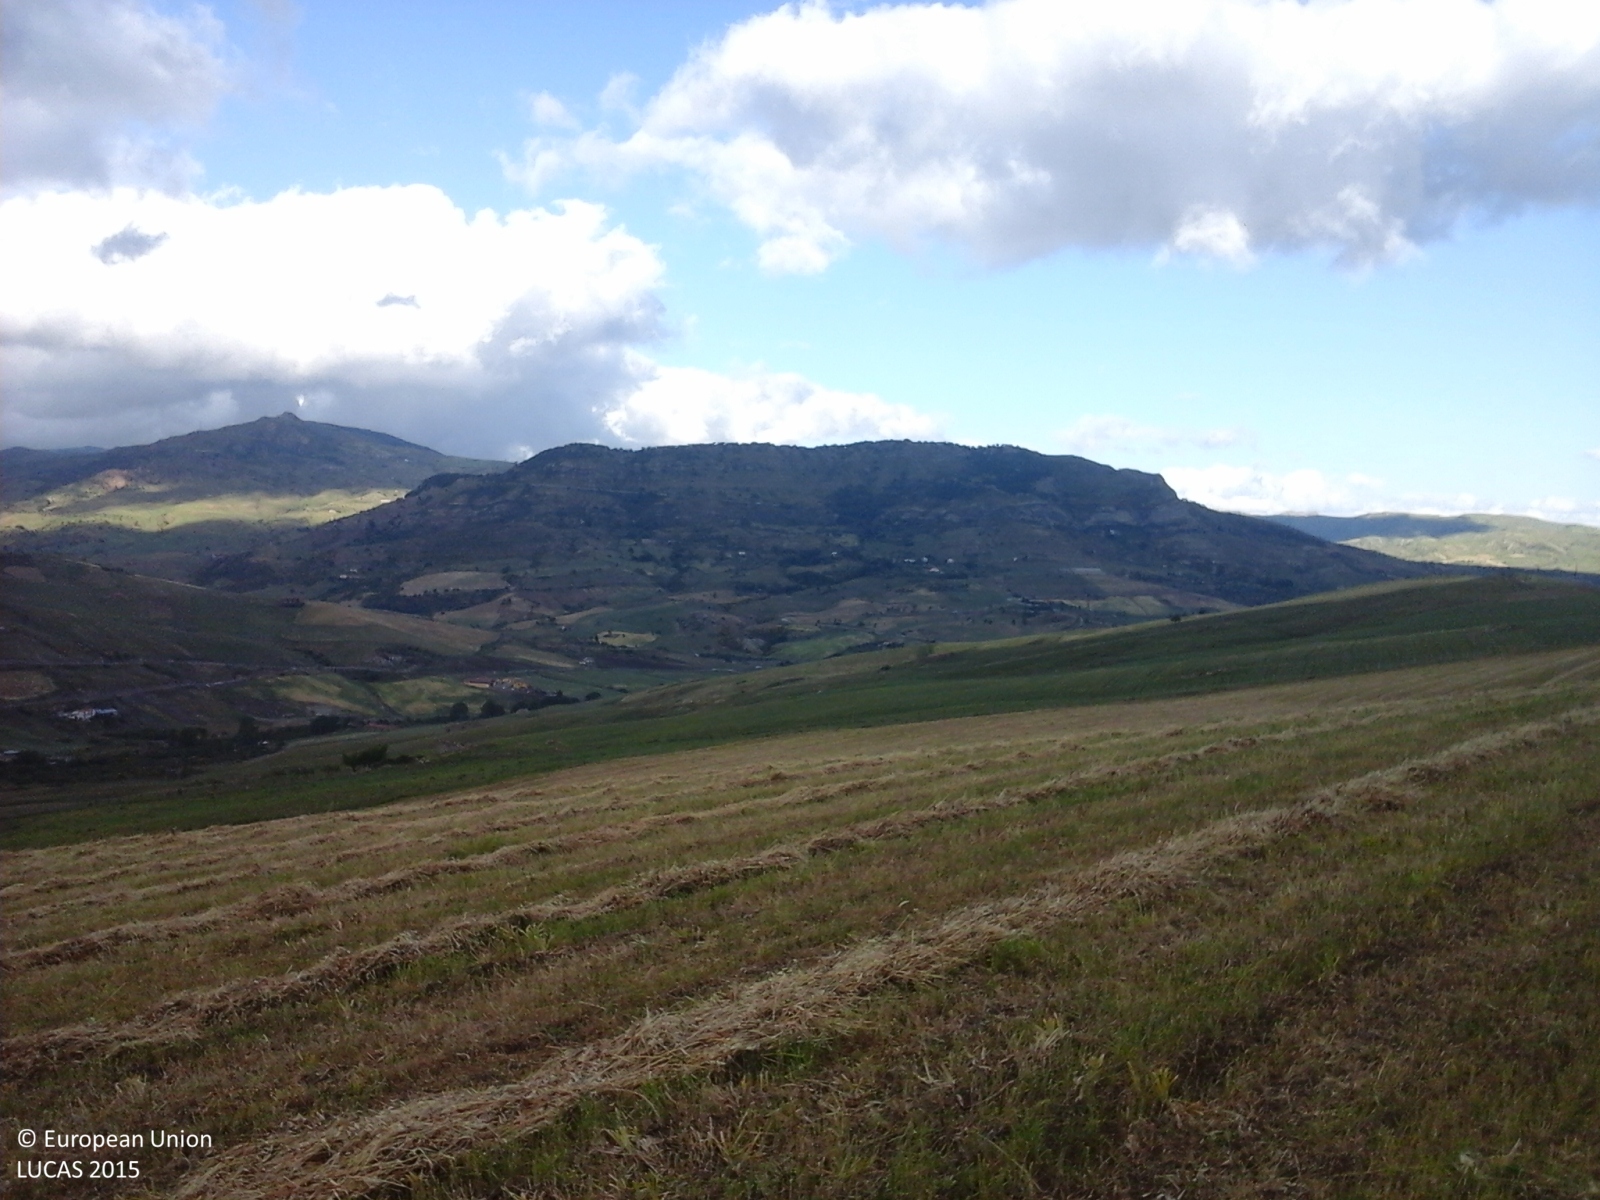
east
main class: Cropland
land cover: Temporary grasslands
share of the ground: > 75 %
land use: Agriculture (excluding fallow land and kitchen gardens)
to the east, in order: Temporary grasslands; Fences; Barley; Fences; Grass margins; Tracks; Grass margins; Fences; Dry pulses
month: May
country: IT
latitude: 37.8067
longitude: 14.4551
